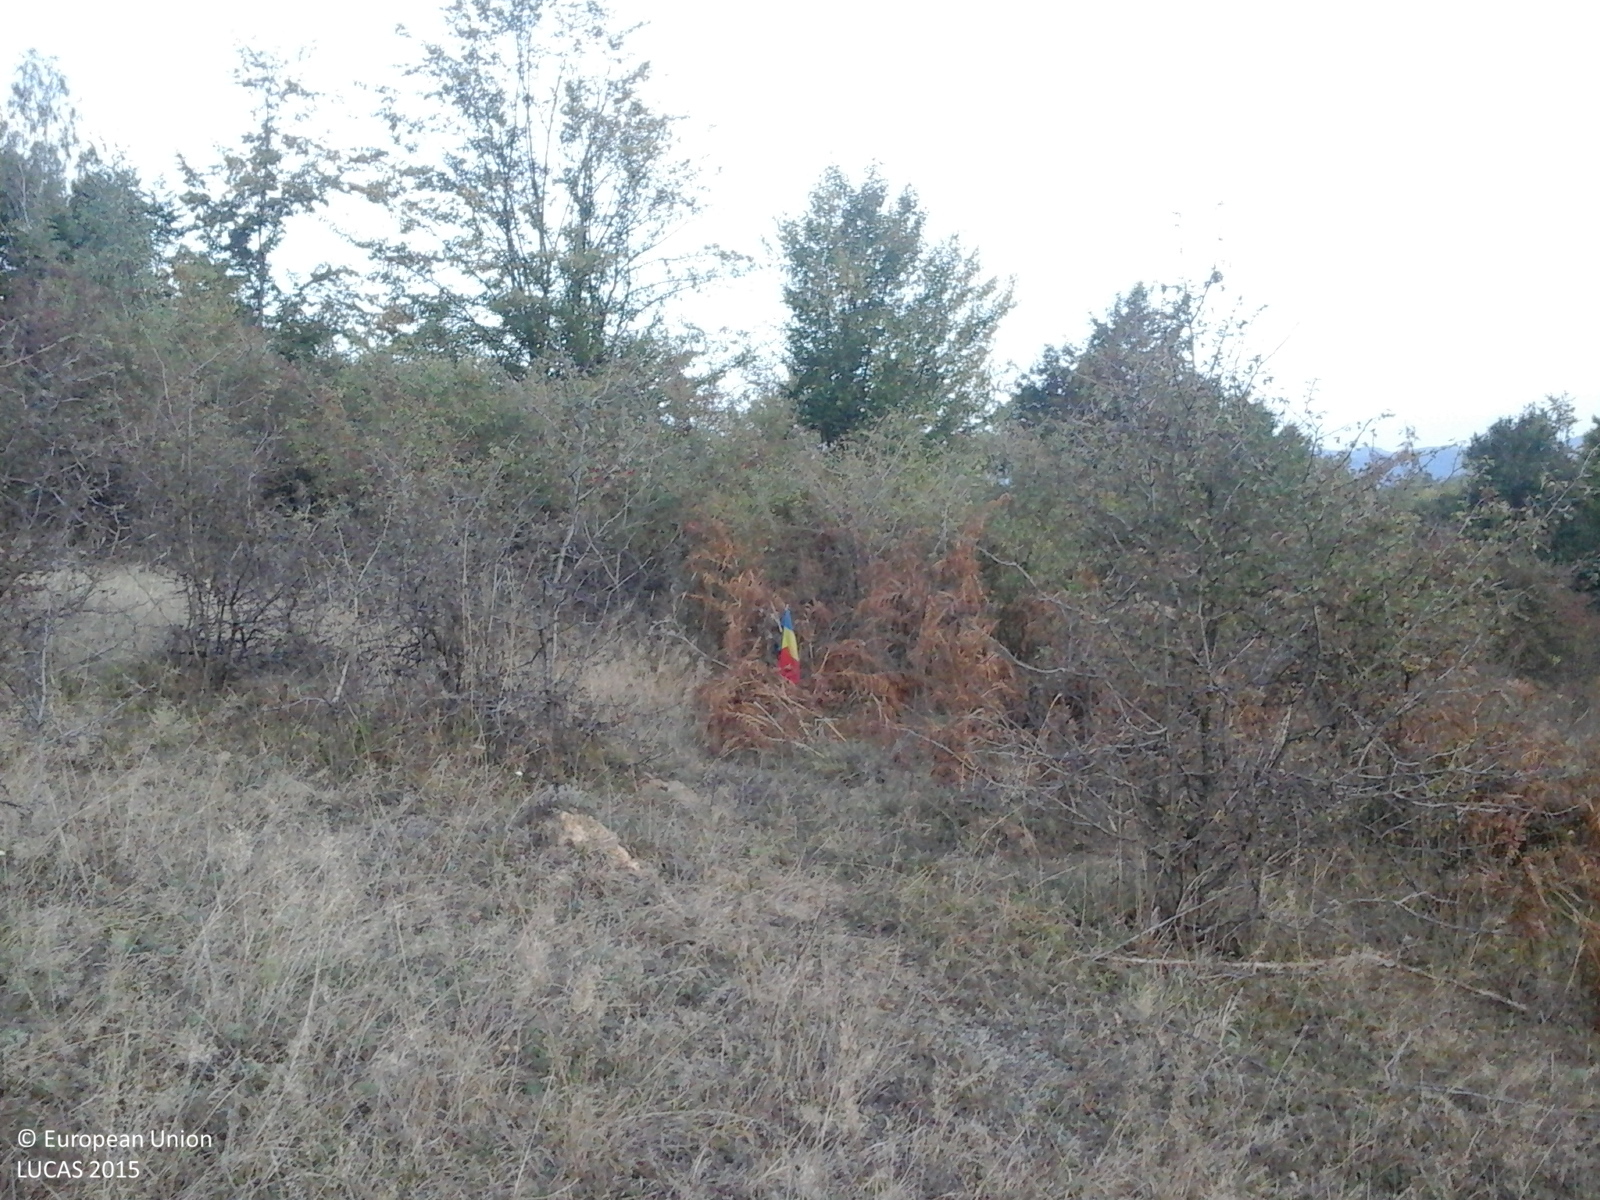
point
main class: Shrubland
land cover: Shrubland without tree cover
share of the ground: > 75 %
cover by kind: shrubs 100 %
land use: Semi-natural and natural areas not in use
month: September
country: RO
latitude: 47.4379
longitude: 23.8298
